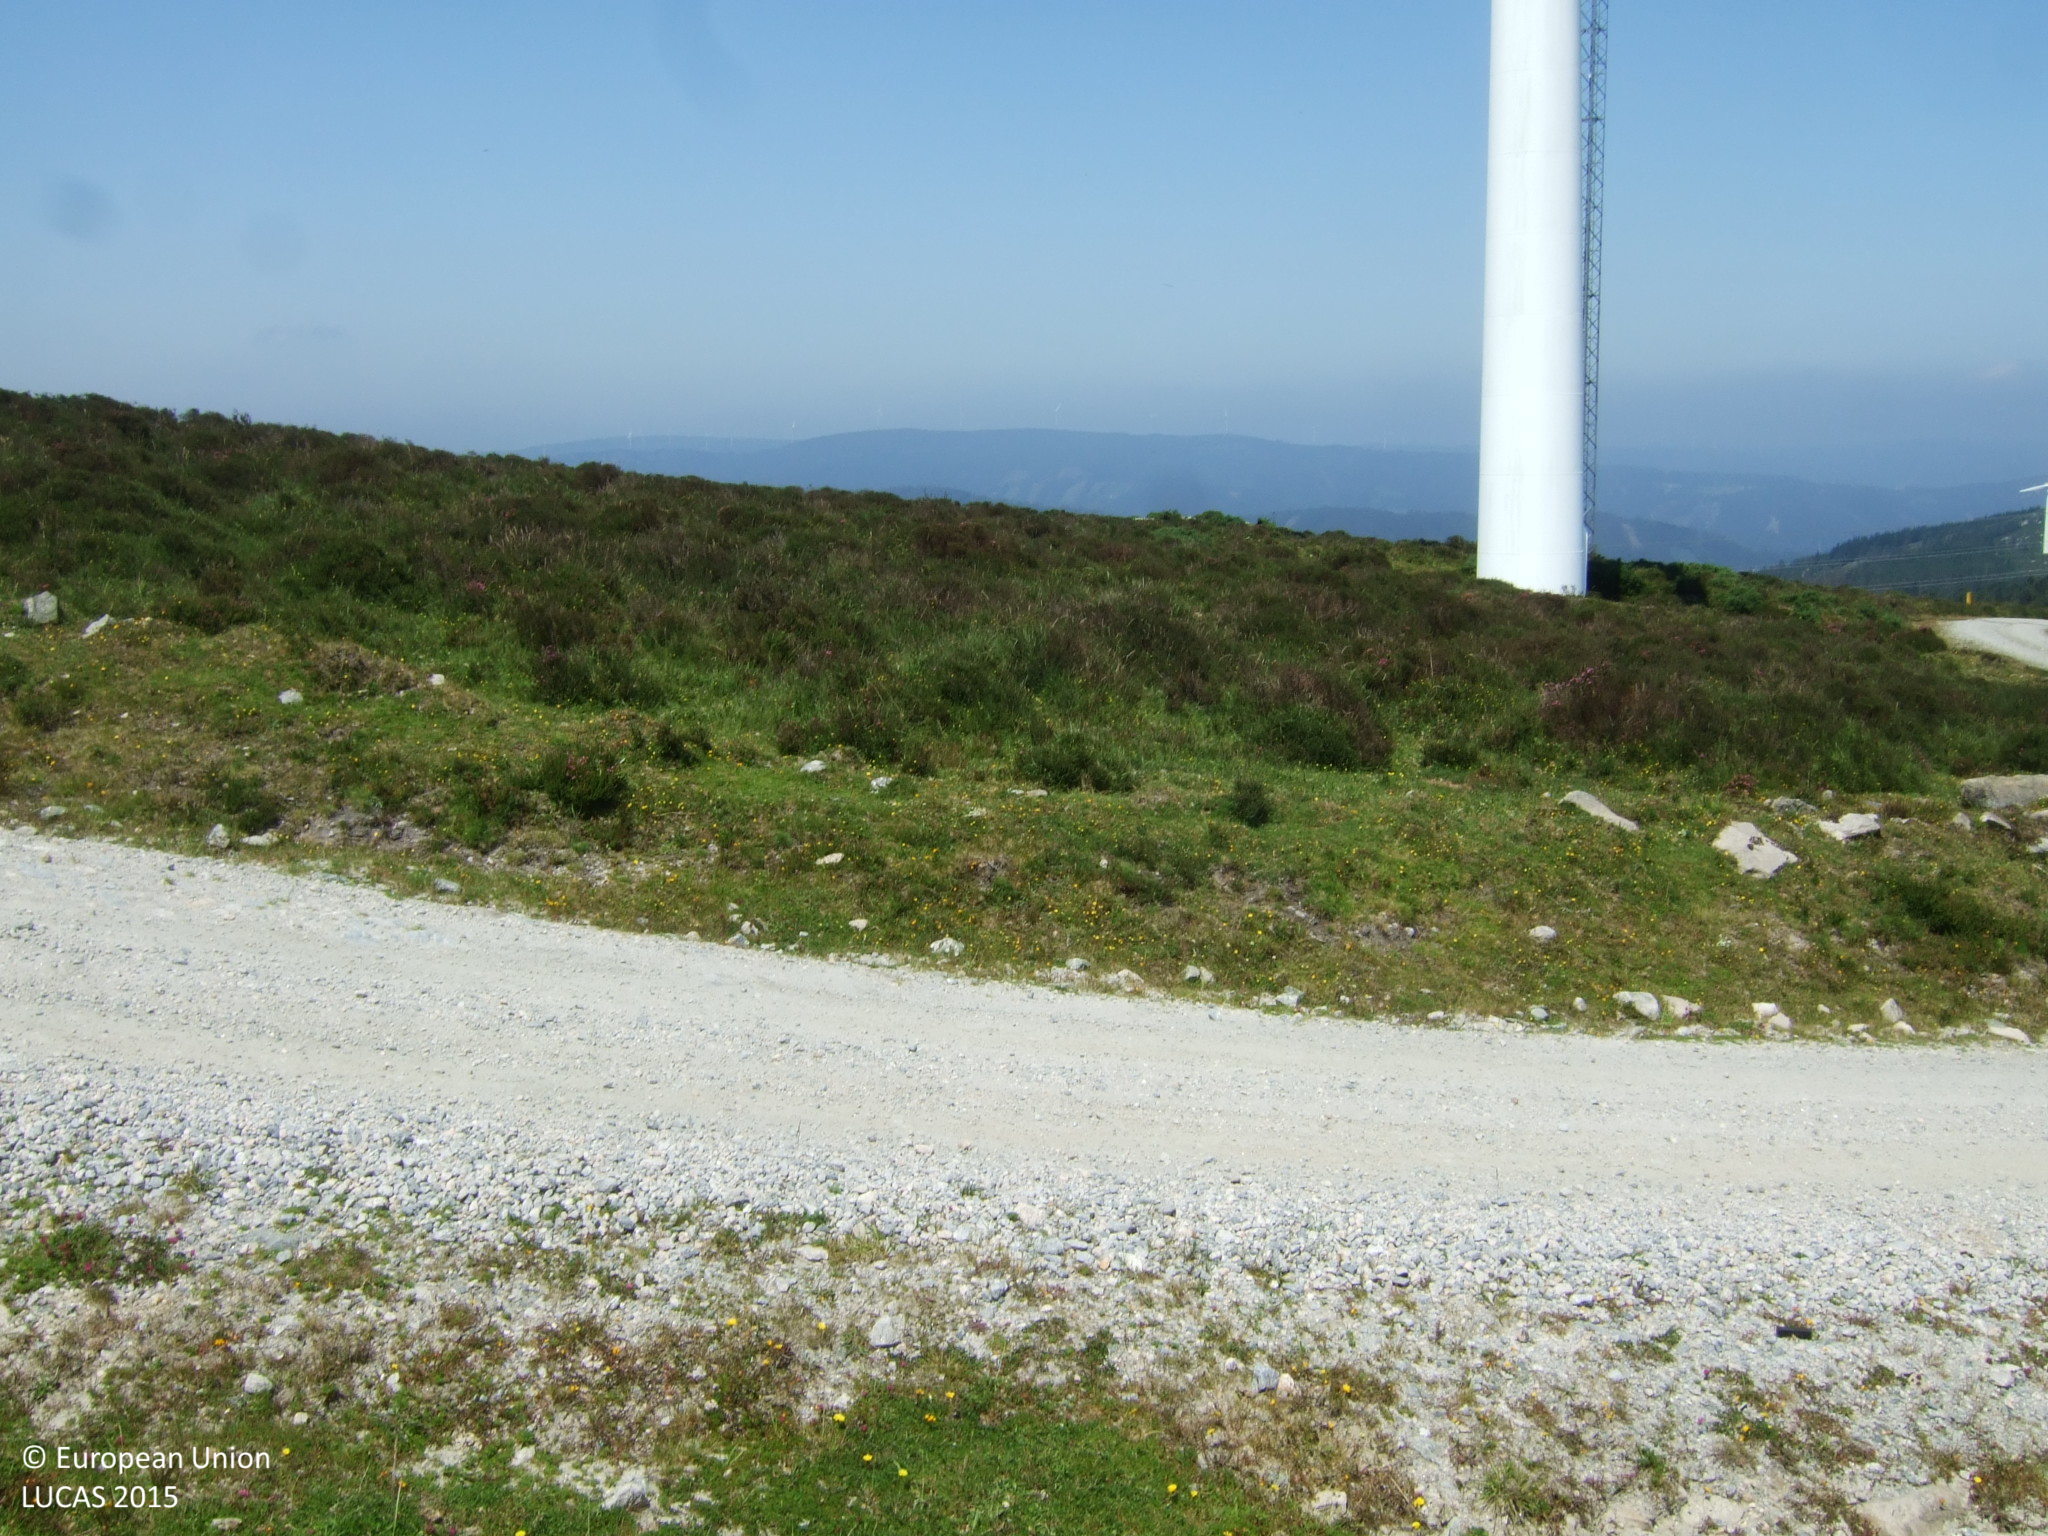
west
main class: Grassland
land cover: Grassland without tree/shrub cover
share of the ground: > 75 %
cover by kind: herbaceous plants 95 %, shrubs 5 %
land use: Agriculture (excluding fallow land and kitchen gardens)
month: June
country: ES
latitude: 43.5372
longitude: -7.5700
